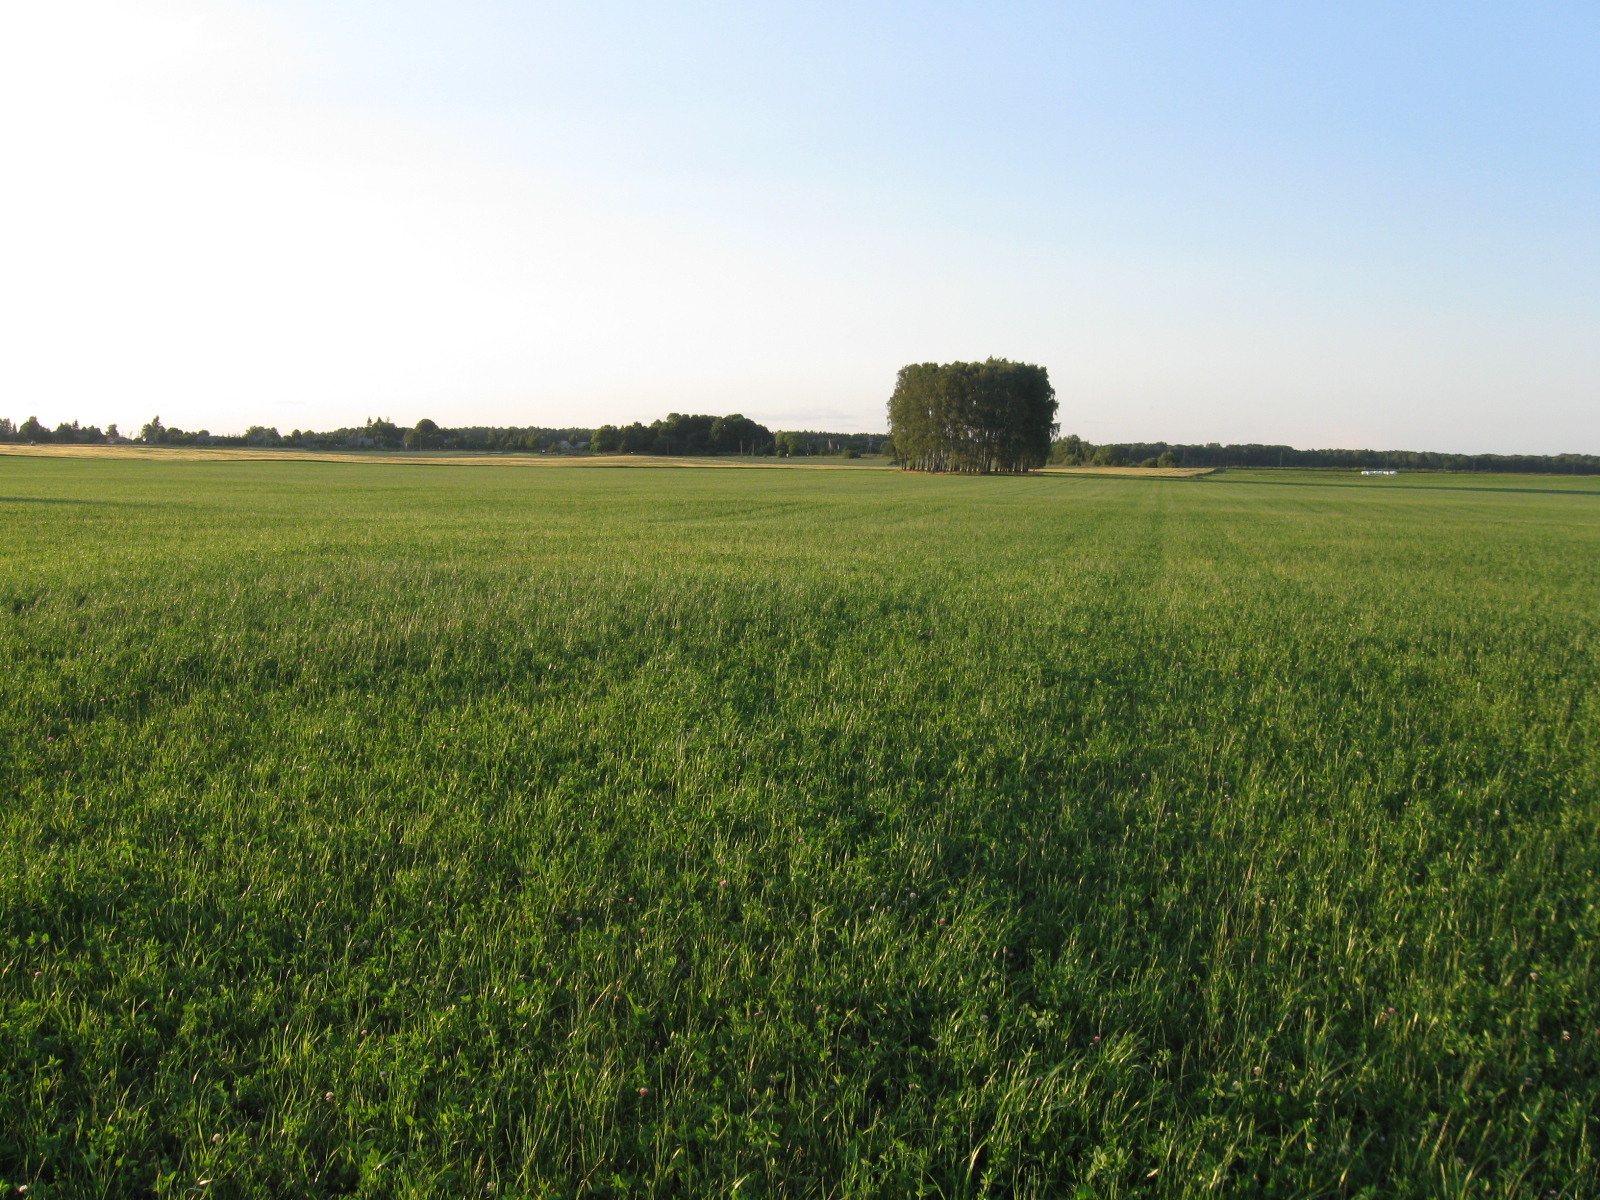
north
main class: Cropland
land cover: Other leguminous and mixtures for fodder
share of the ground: > 75 %
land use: Agriculture (excluding fallow land and kitchen gardens)
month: July
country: LT
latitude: 55.0900
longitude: 23.6360
